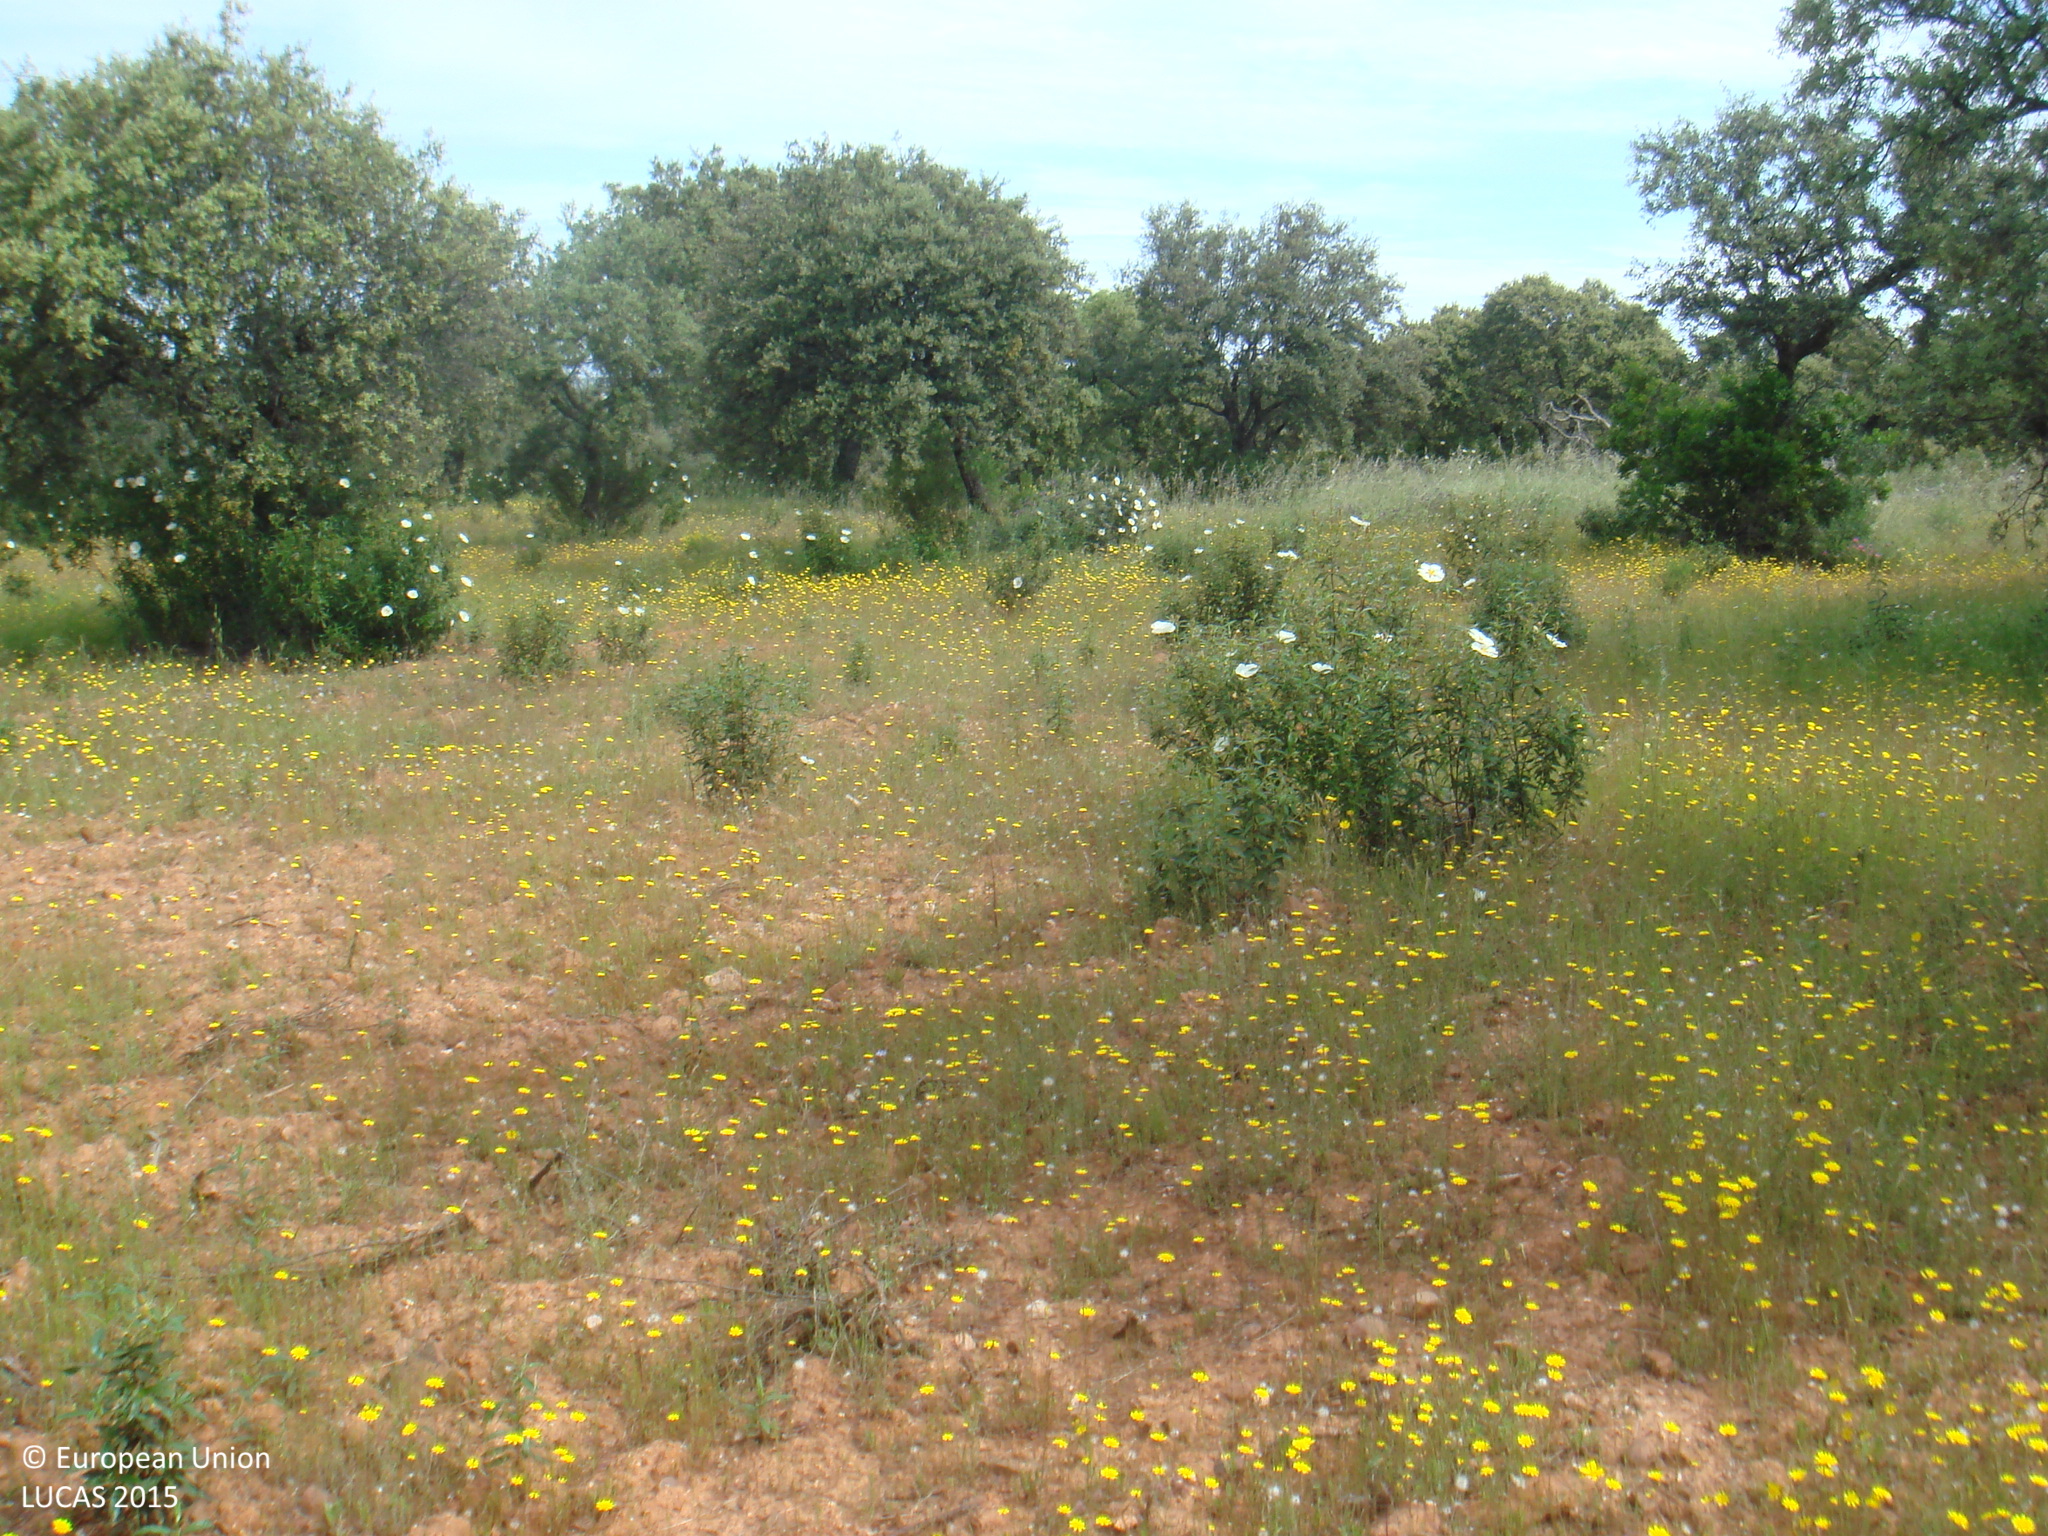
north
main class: Woodland
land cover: Broadleaved woodland
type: broadleaved evergreen forest
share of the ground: 25 - 50 %
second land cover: Shrubland without tree cover
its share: 25 - 50 %
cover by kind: herbaceous plants 50 %, shrubs 30 %, broadleaved forest trees 20 %
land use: Forestry
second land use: Agriculture (excluding fallow land and kitchen gardens)
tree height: > 5 m
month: May
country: ES
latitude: 38.3526
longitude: -5.1204
